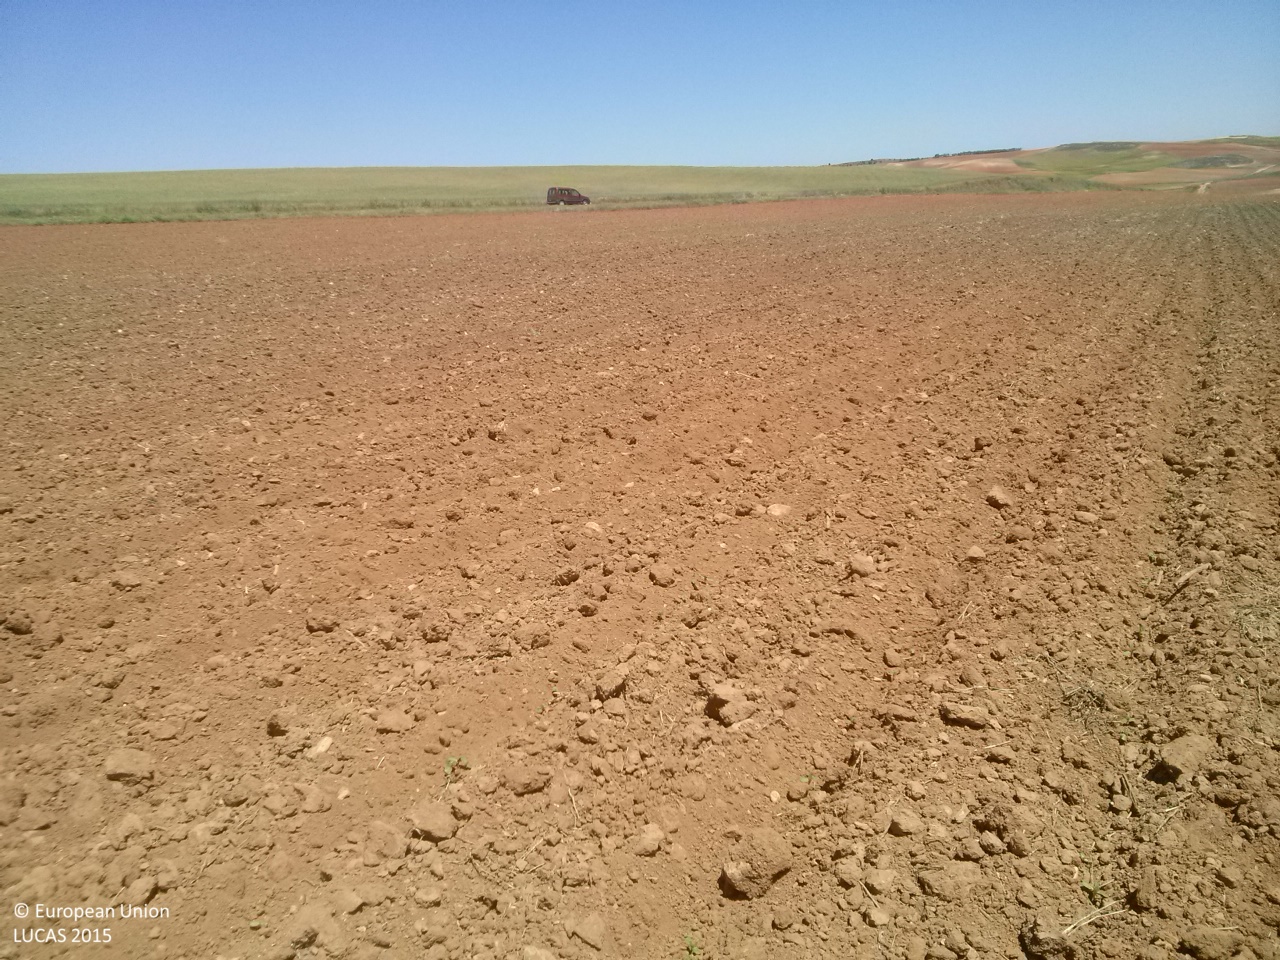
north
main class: Cropland
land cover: Sunflower
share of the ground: < 10 %
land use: Agriculture (excluding fallow land and kitchen gardens)
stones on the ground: < 10 %
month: May
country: ES
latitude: 40.2361
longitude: -2.7533
